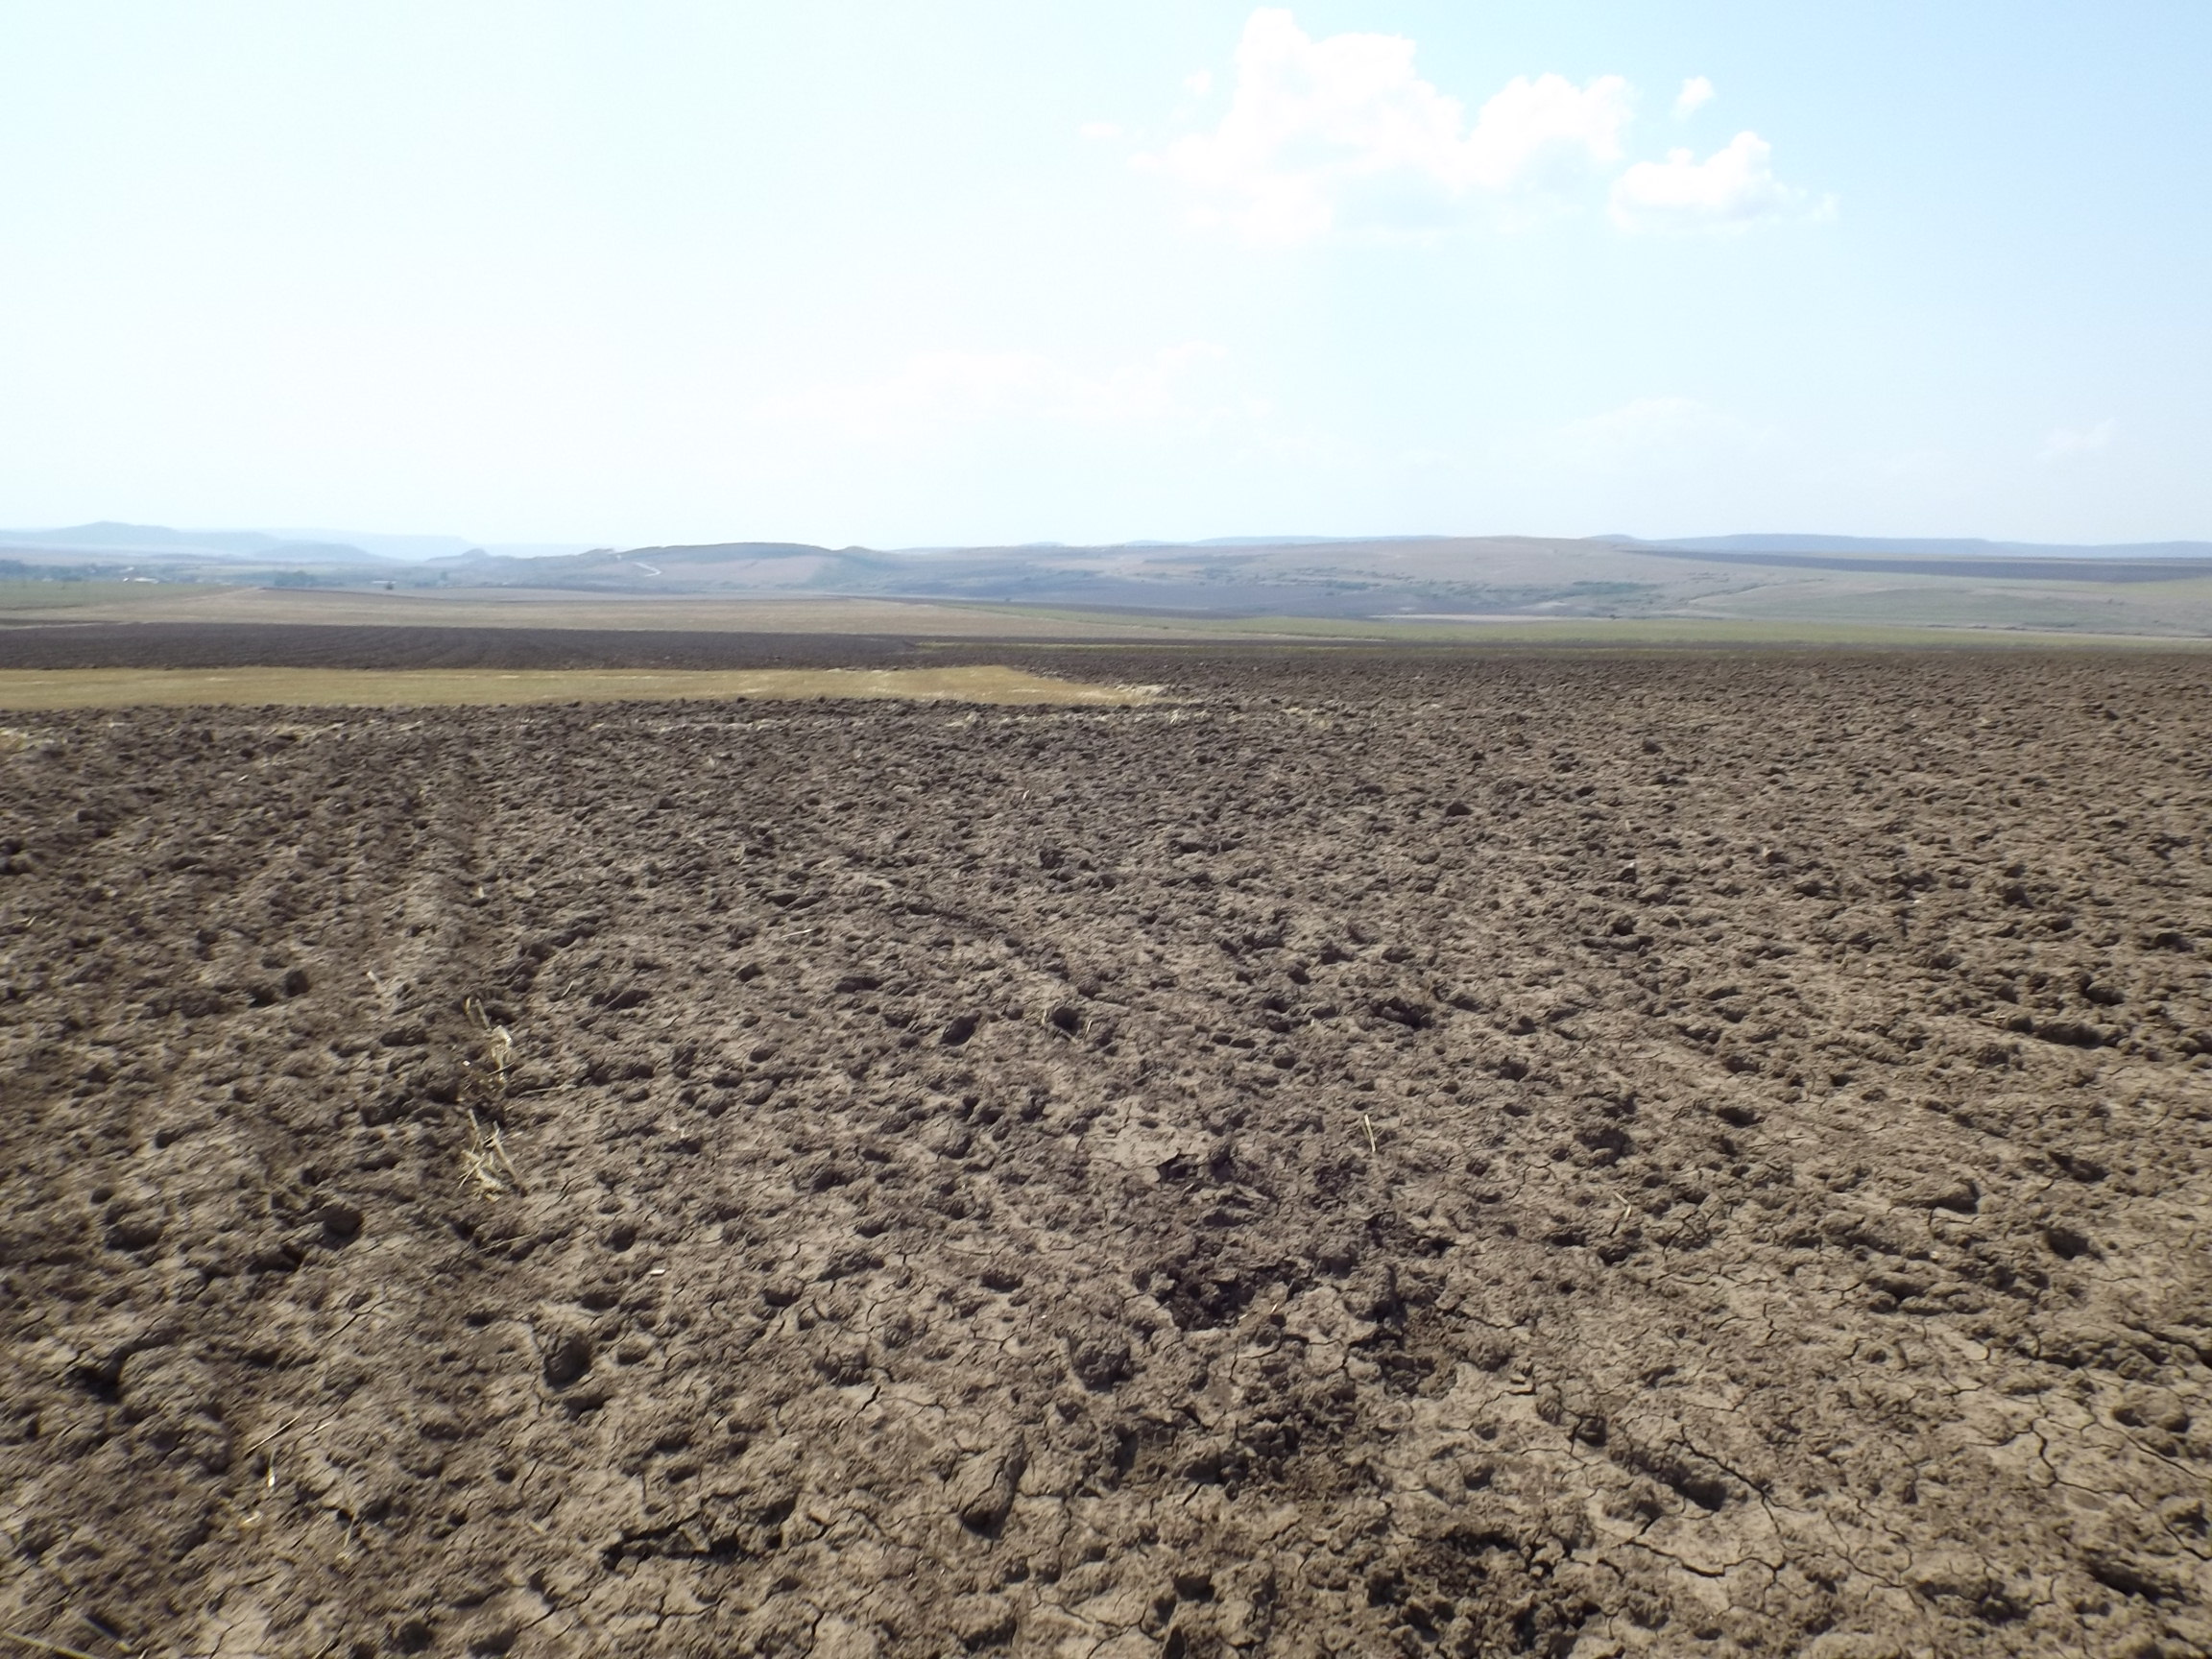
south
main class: Cropland
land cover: Common wheat
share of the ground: < 10 %
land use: Agriculture (excluding fallow land and kitchen gardens)
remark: Harvested field
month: August
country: BG
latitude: 43.3147
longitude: 27.5776
